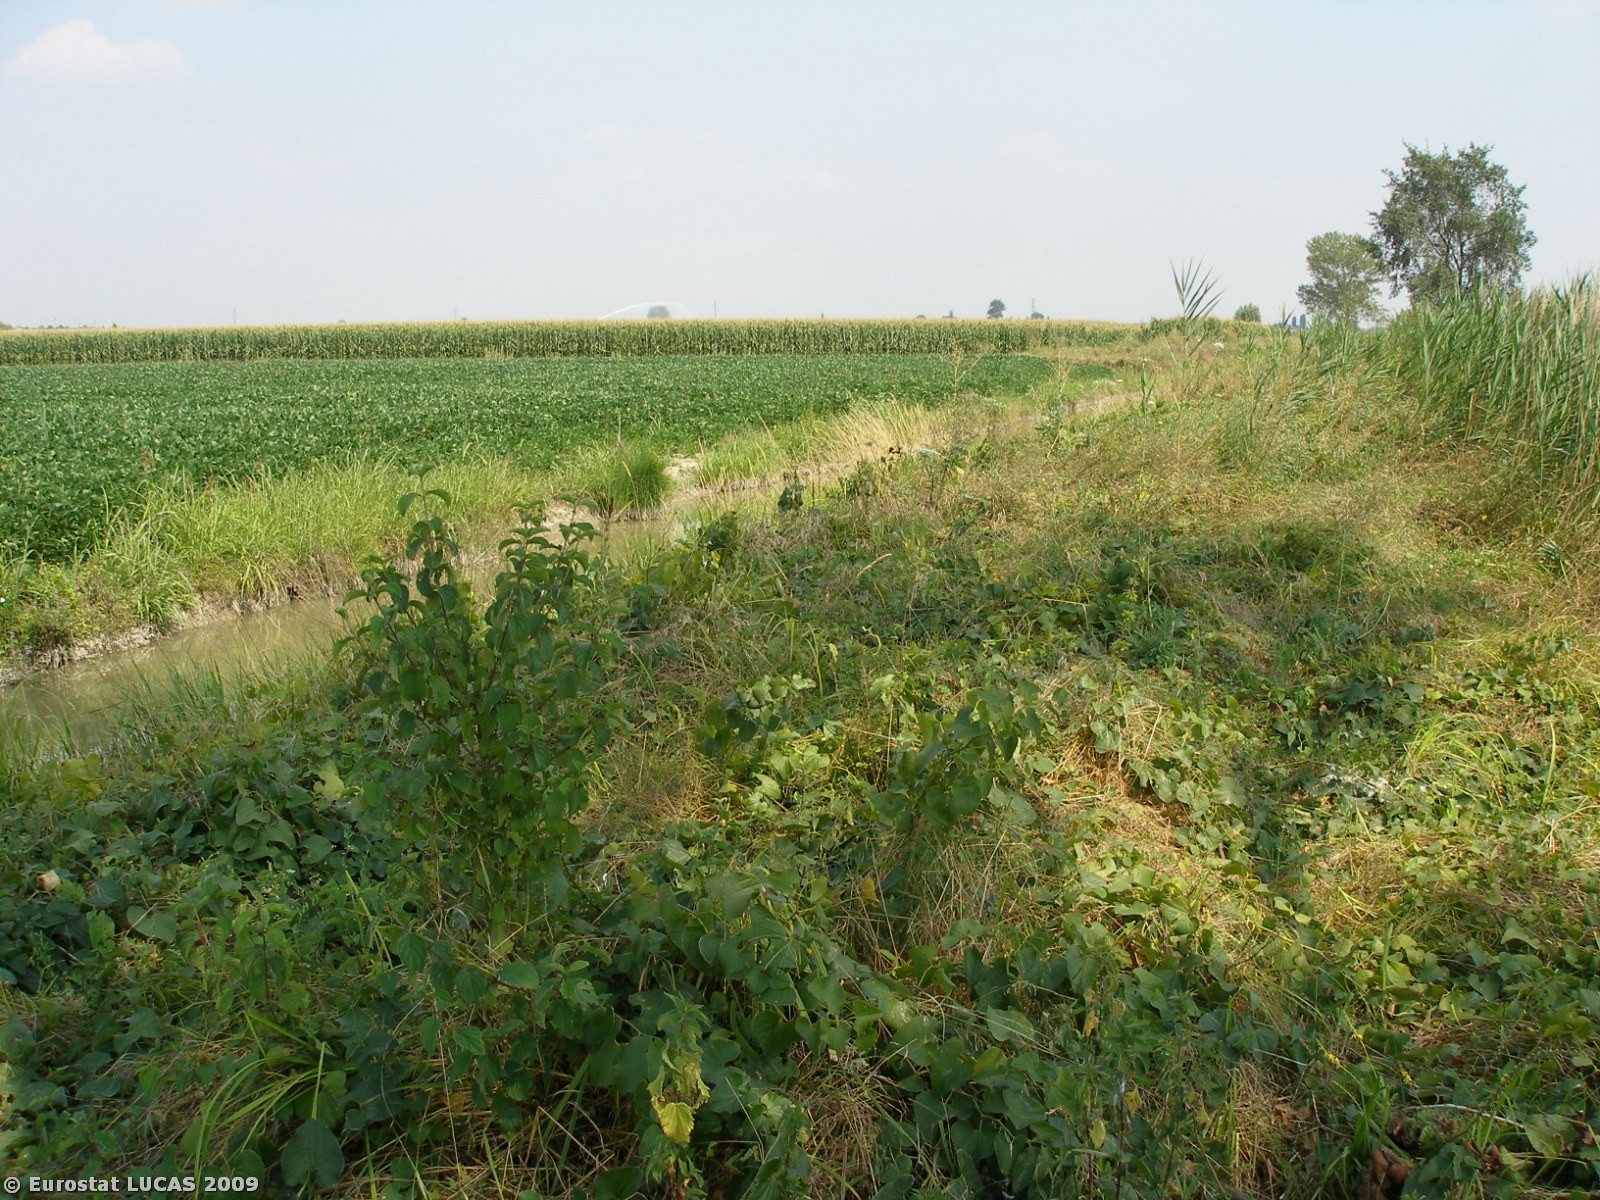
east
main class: Cropland
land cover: Maize
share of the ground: > 75 %
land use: Agriculture (excluding fallow land and kitchen gardens)
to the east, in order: Maize; Ditches and canals; Common wheat; Ditches and canals; Common wheat; Ditches and canals; Grass margins; Ditches and canals; Common wheat
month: July
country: IT
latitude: 44.9505
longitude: 11.6573
